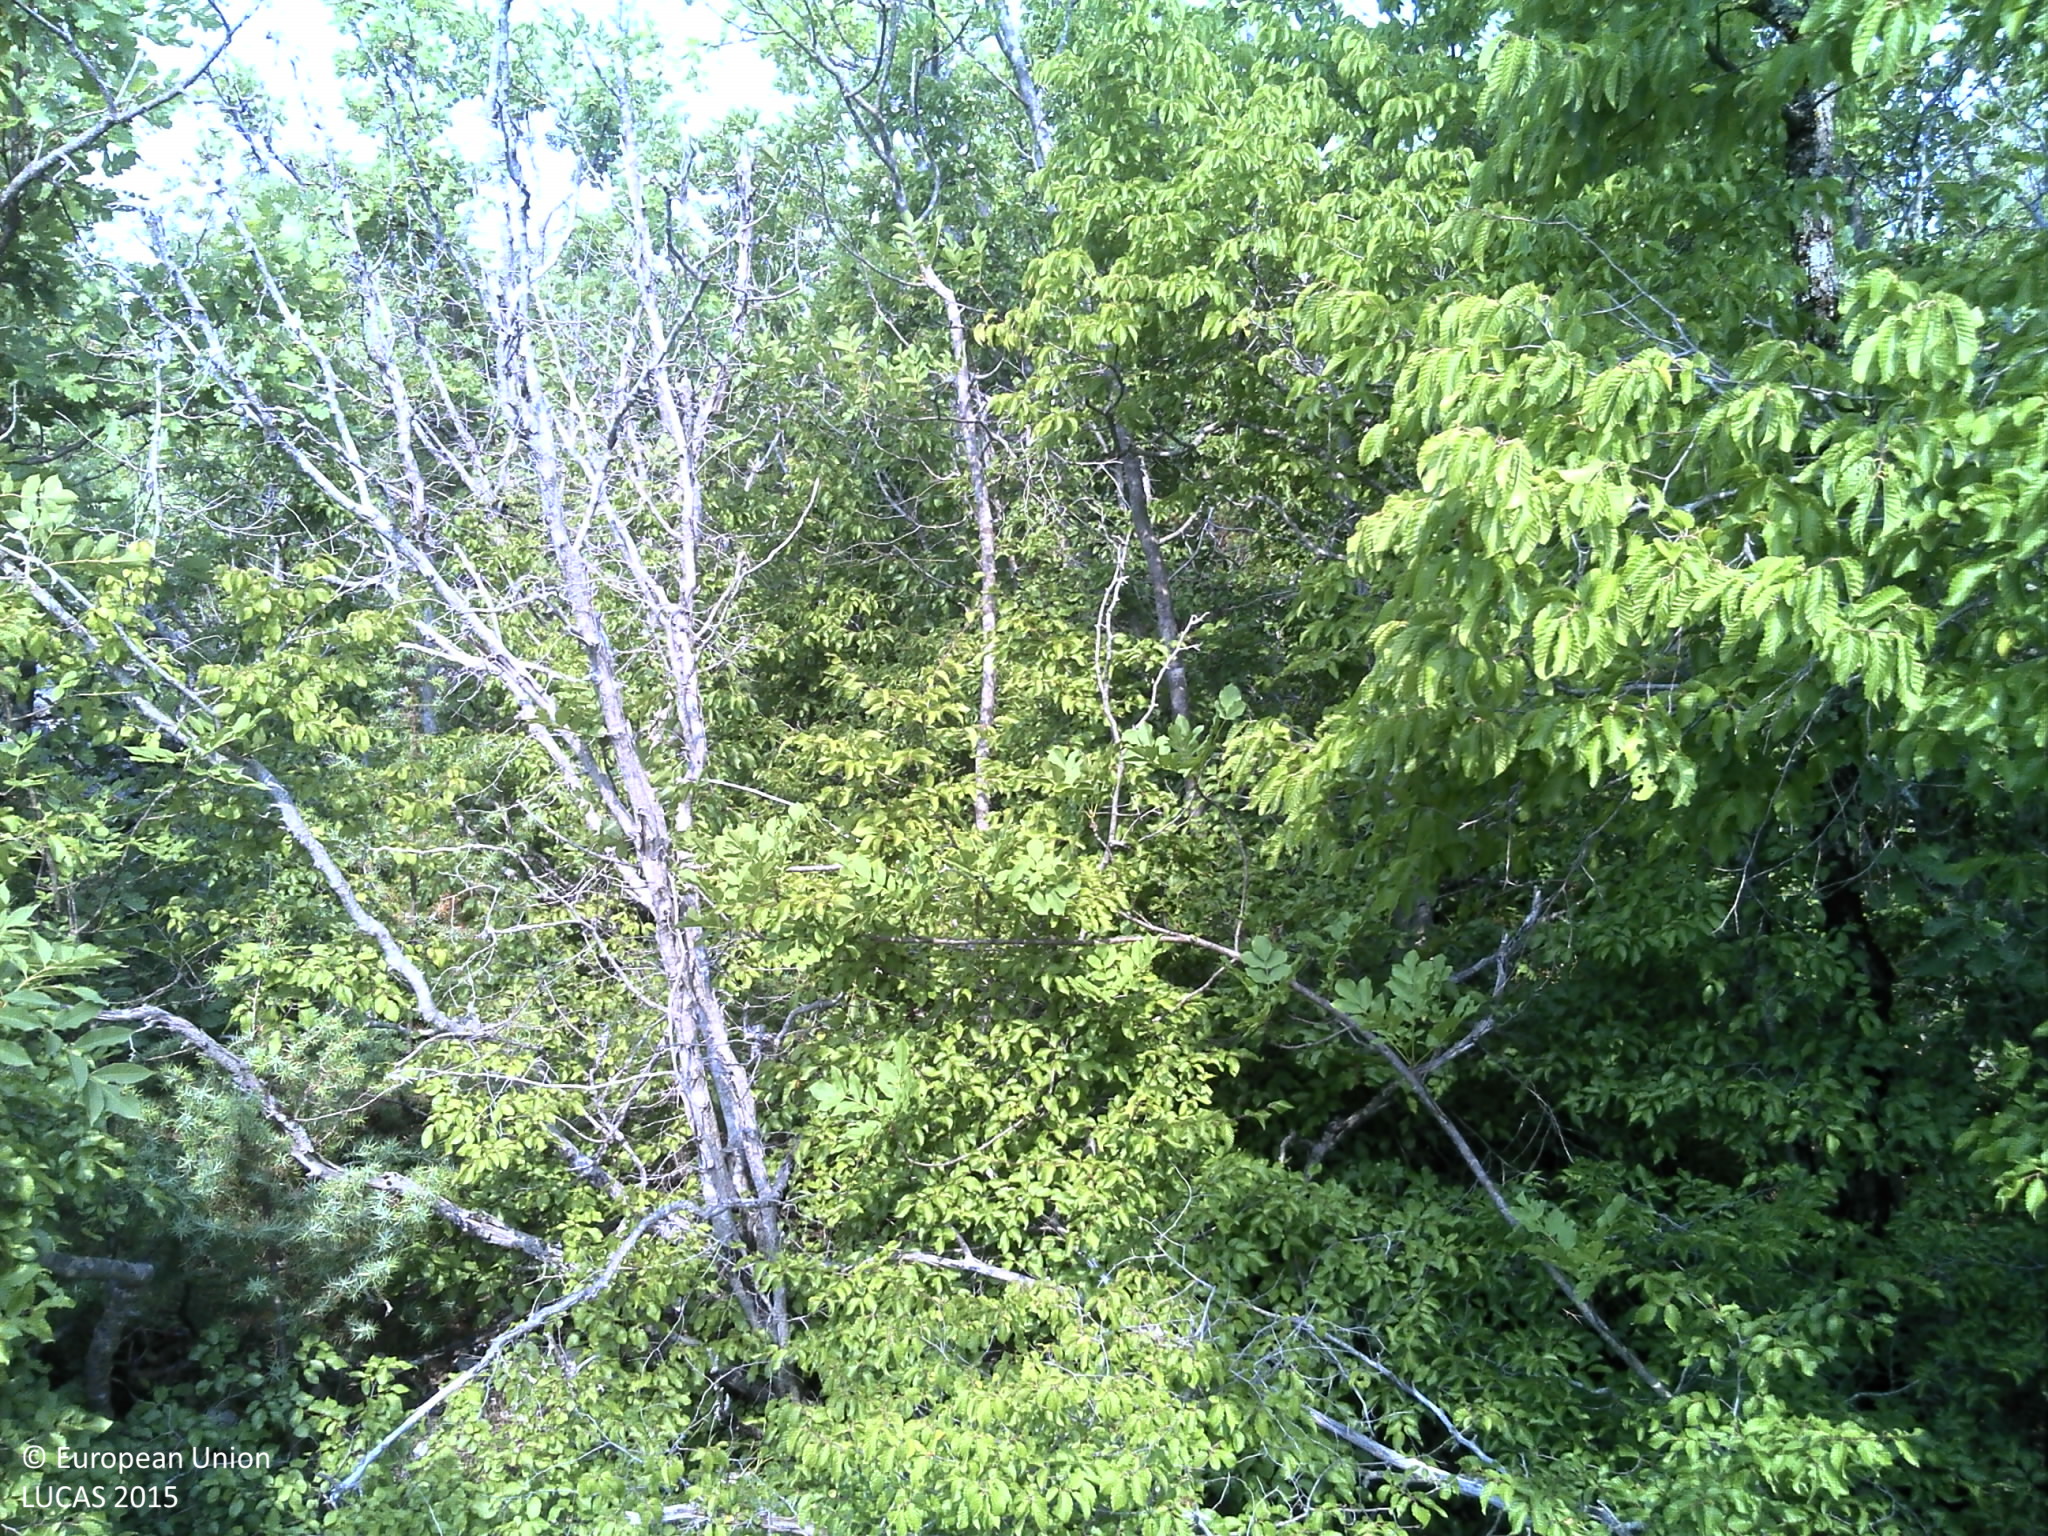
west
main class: Woodland
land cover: Other mixed woodland
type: thermophilous deciduous forest
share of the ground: > 75 %
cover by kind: broadleaved forest trees 45 %, coniferous forest trees 30 %, shrubs 10 %, consolidated bare surface 10 %, herbaceous plants 5 %
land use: Semi-natural and natural areas not in use
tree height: > 5 m
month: July
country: HR
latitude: 43.4853
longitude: 16.9280
